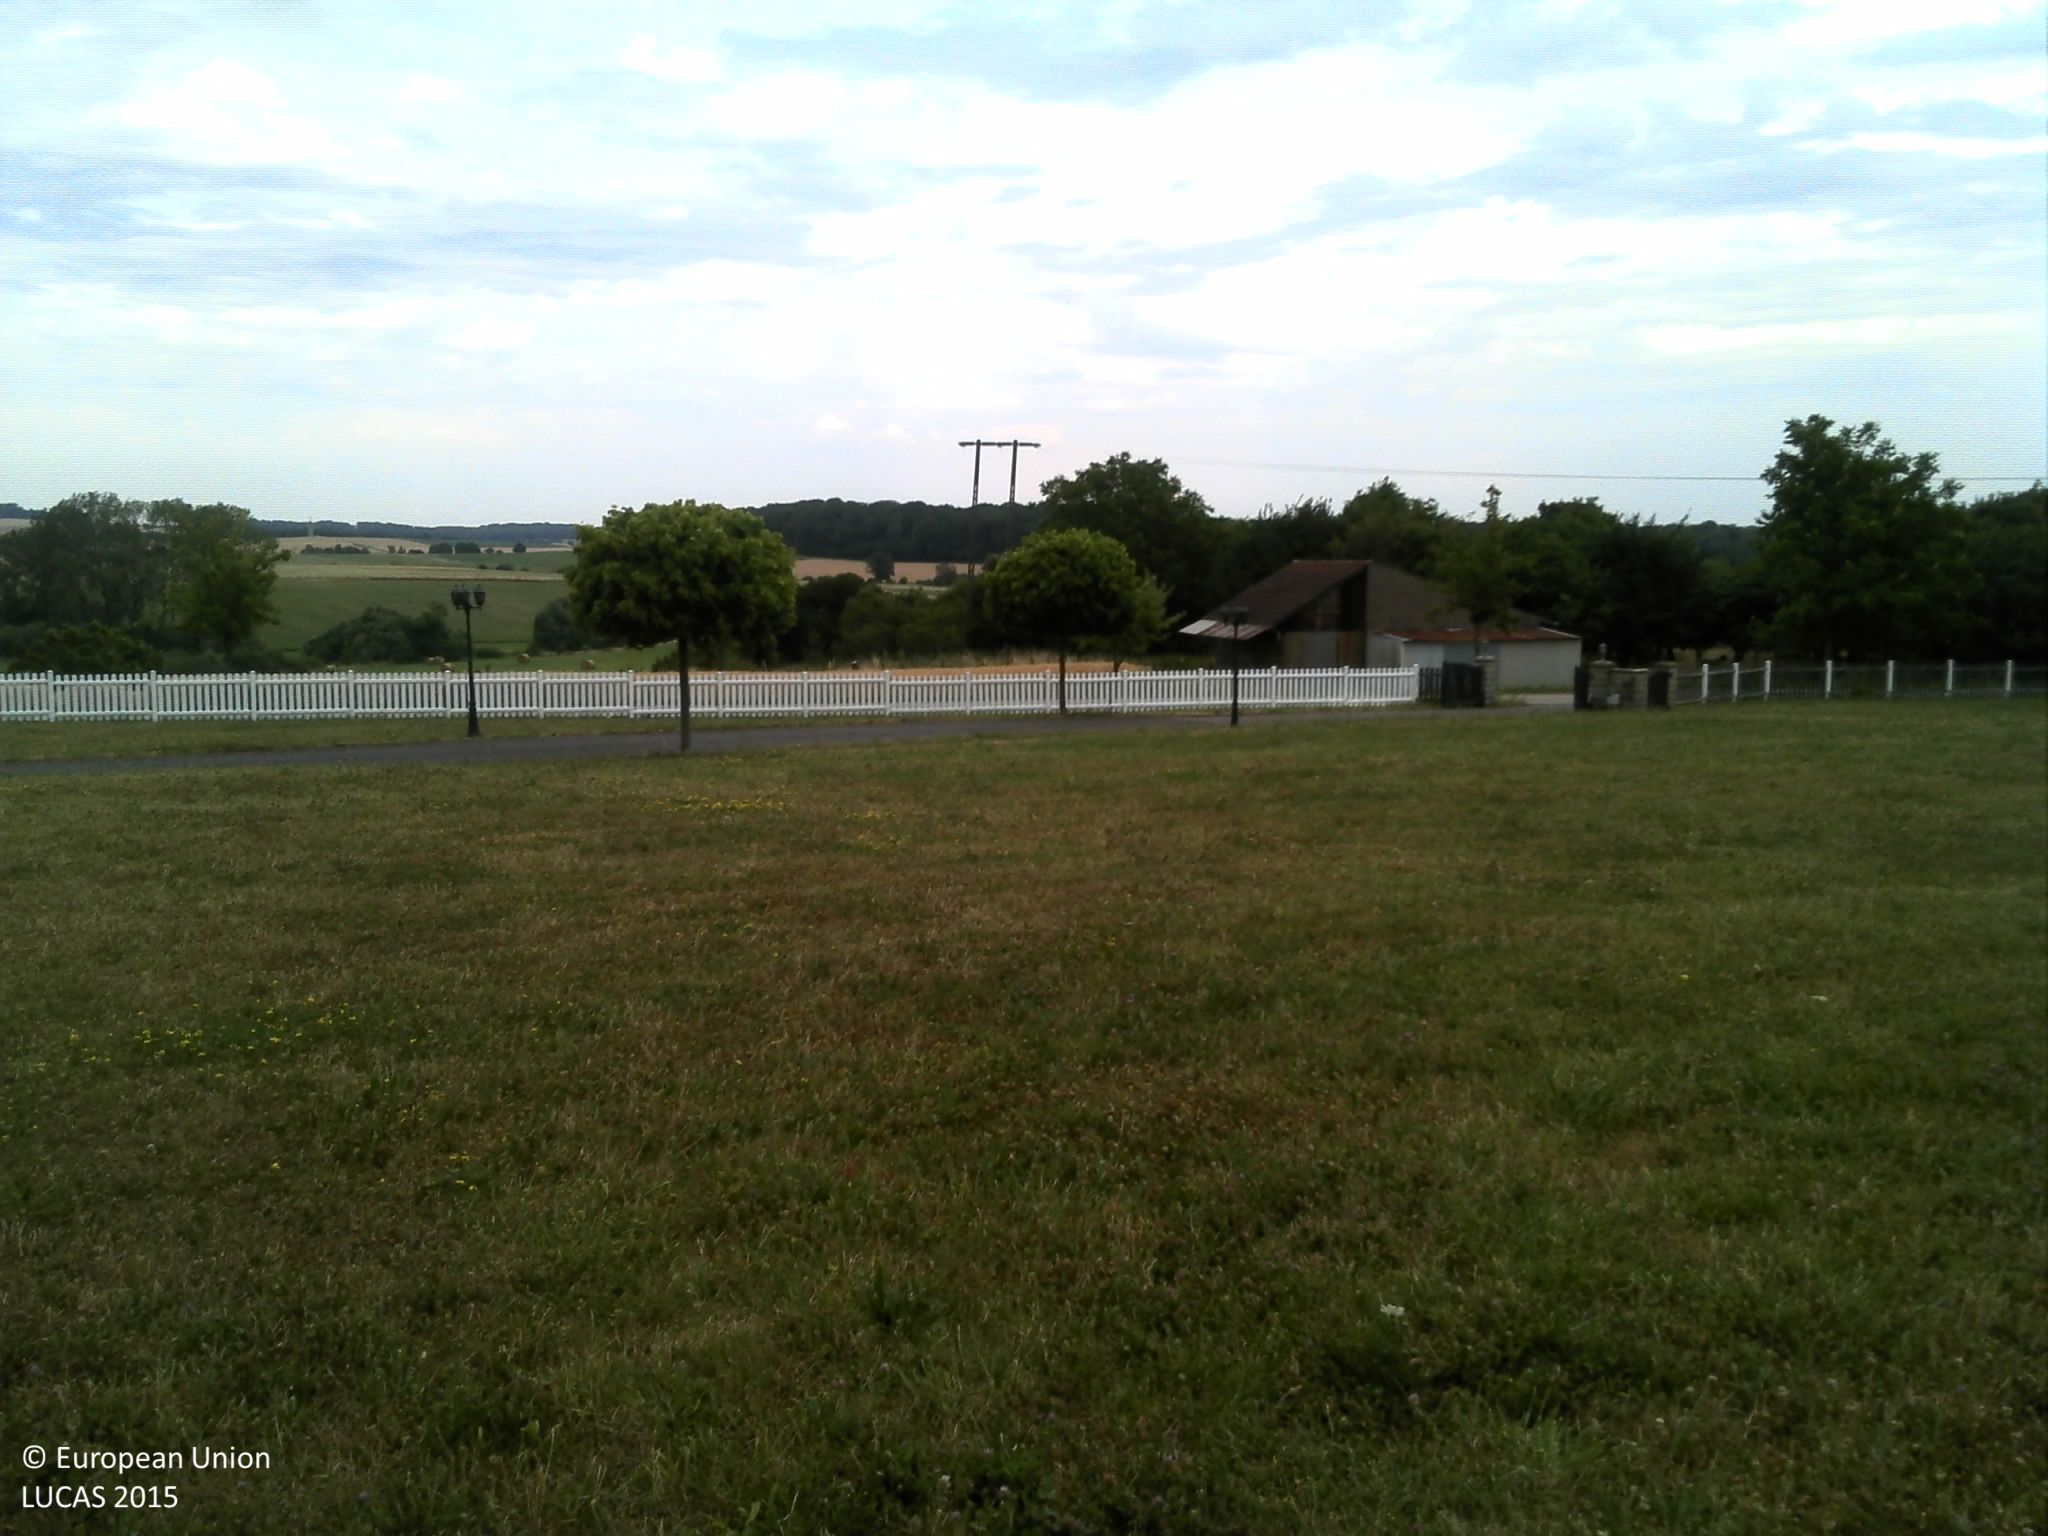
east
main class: Grassland
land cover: Grassland without tree/shrub cover
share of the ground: > 75 %
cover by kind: herbaceous plants 100 %
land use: Residential
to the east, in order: Grassland without tree/shrub cover; Artificial constructions in urban areas; Common wheat; Fences; Grassland without tree/shrub cover; Fences; Grassland without tree/shrub cover; Tracks; Grassland without tree/shrub cover; Broadleaved woodland; Grassland without tree/shrub cover; Electric lines; Grassland without tree/shrub cover
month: July
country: FR
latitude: 49.4100
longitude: 6.4853
